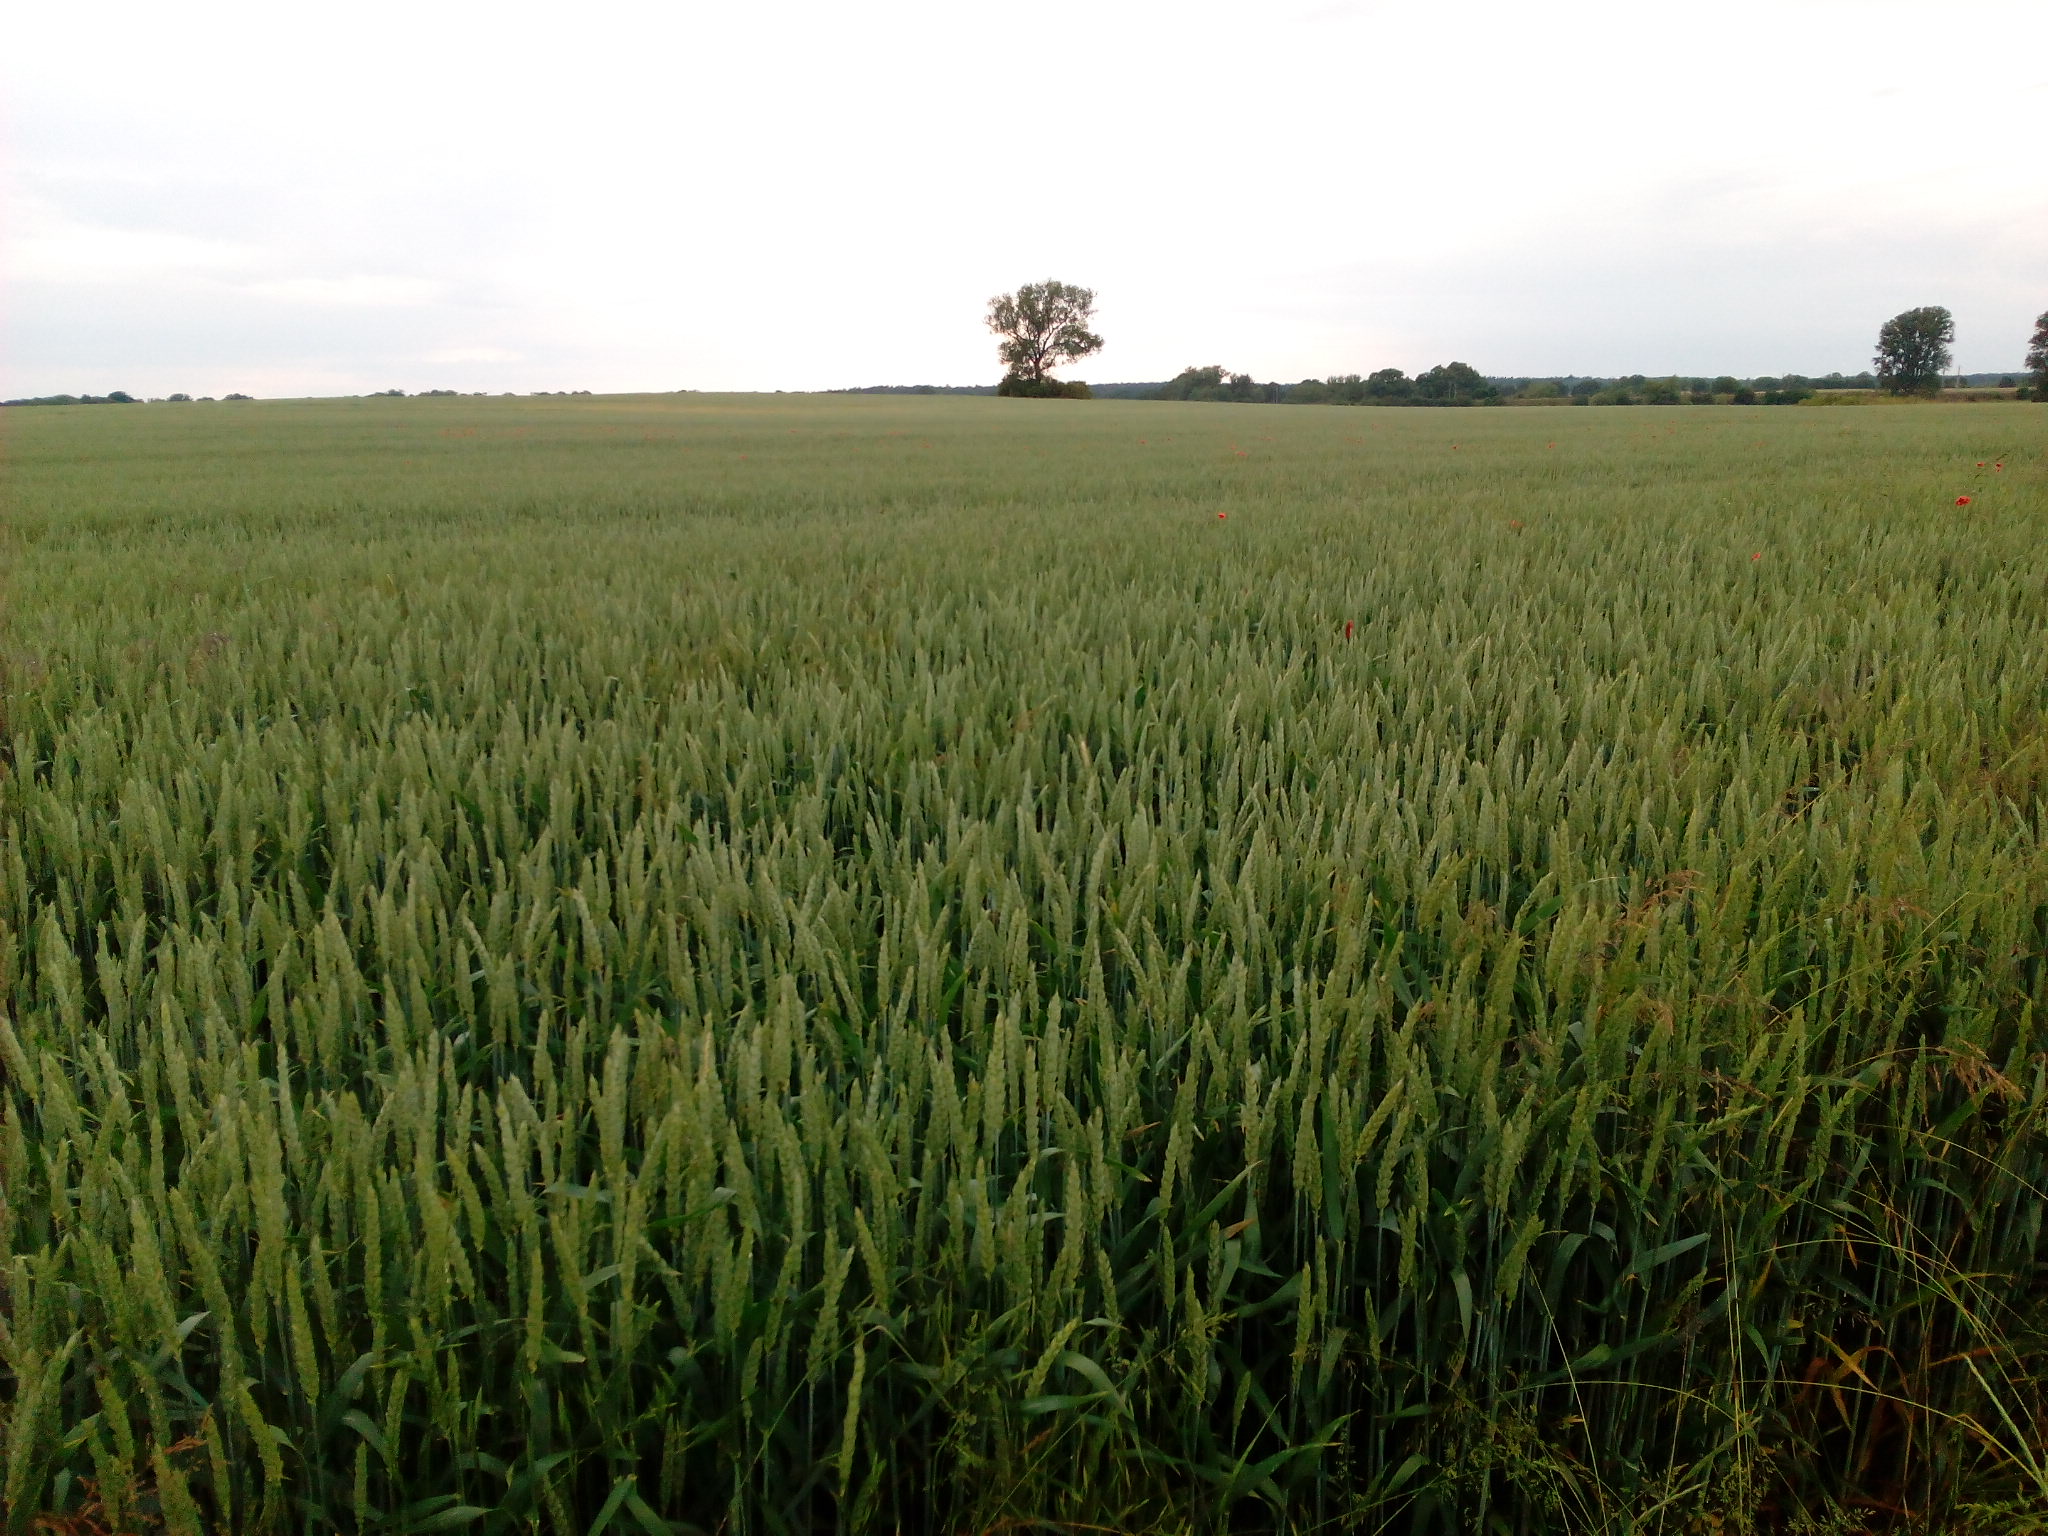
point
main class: Cropland
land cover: Common wheat
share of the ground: > 75 %
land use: Agriculture (excluding fallow land and kitchen gardens)
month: June
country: DE
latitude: 52.9827
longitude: 13.1723
